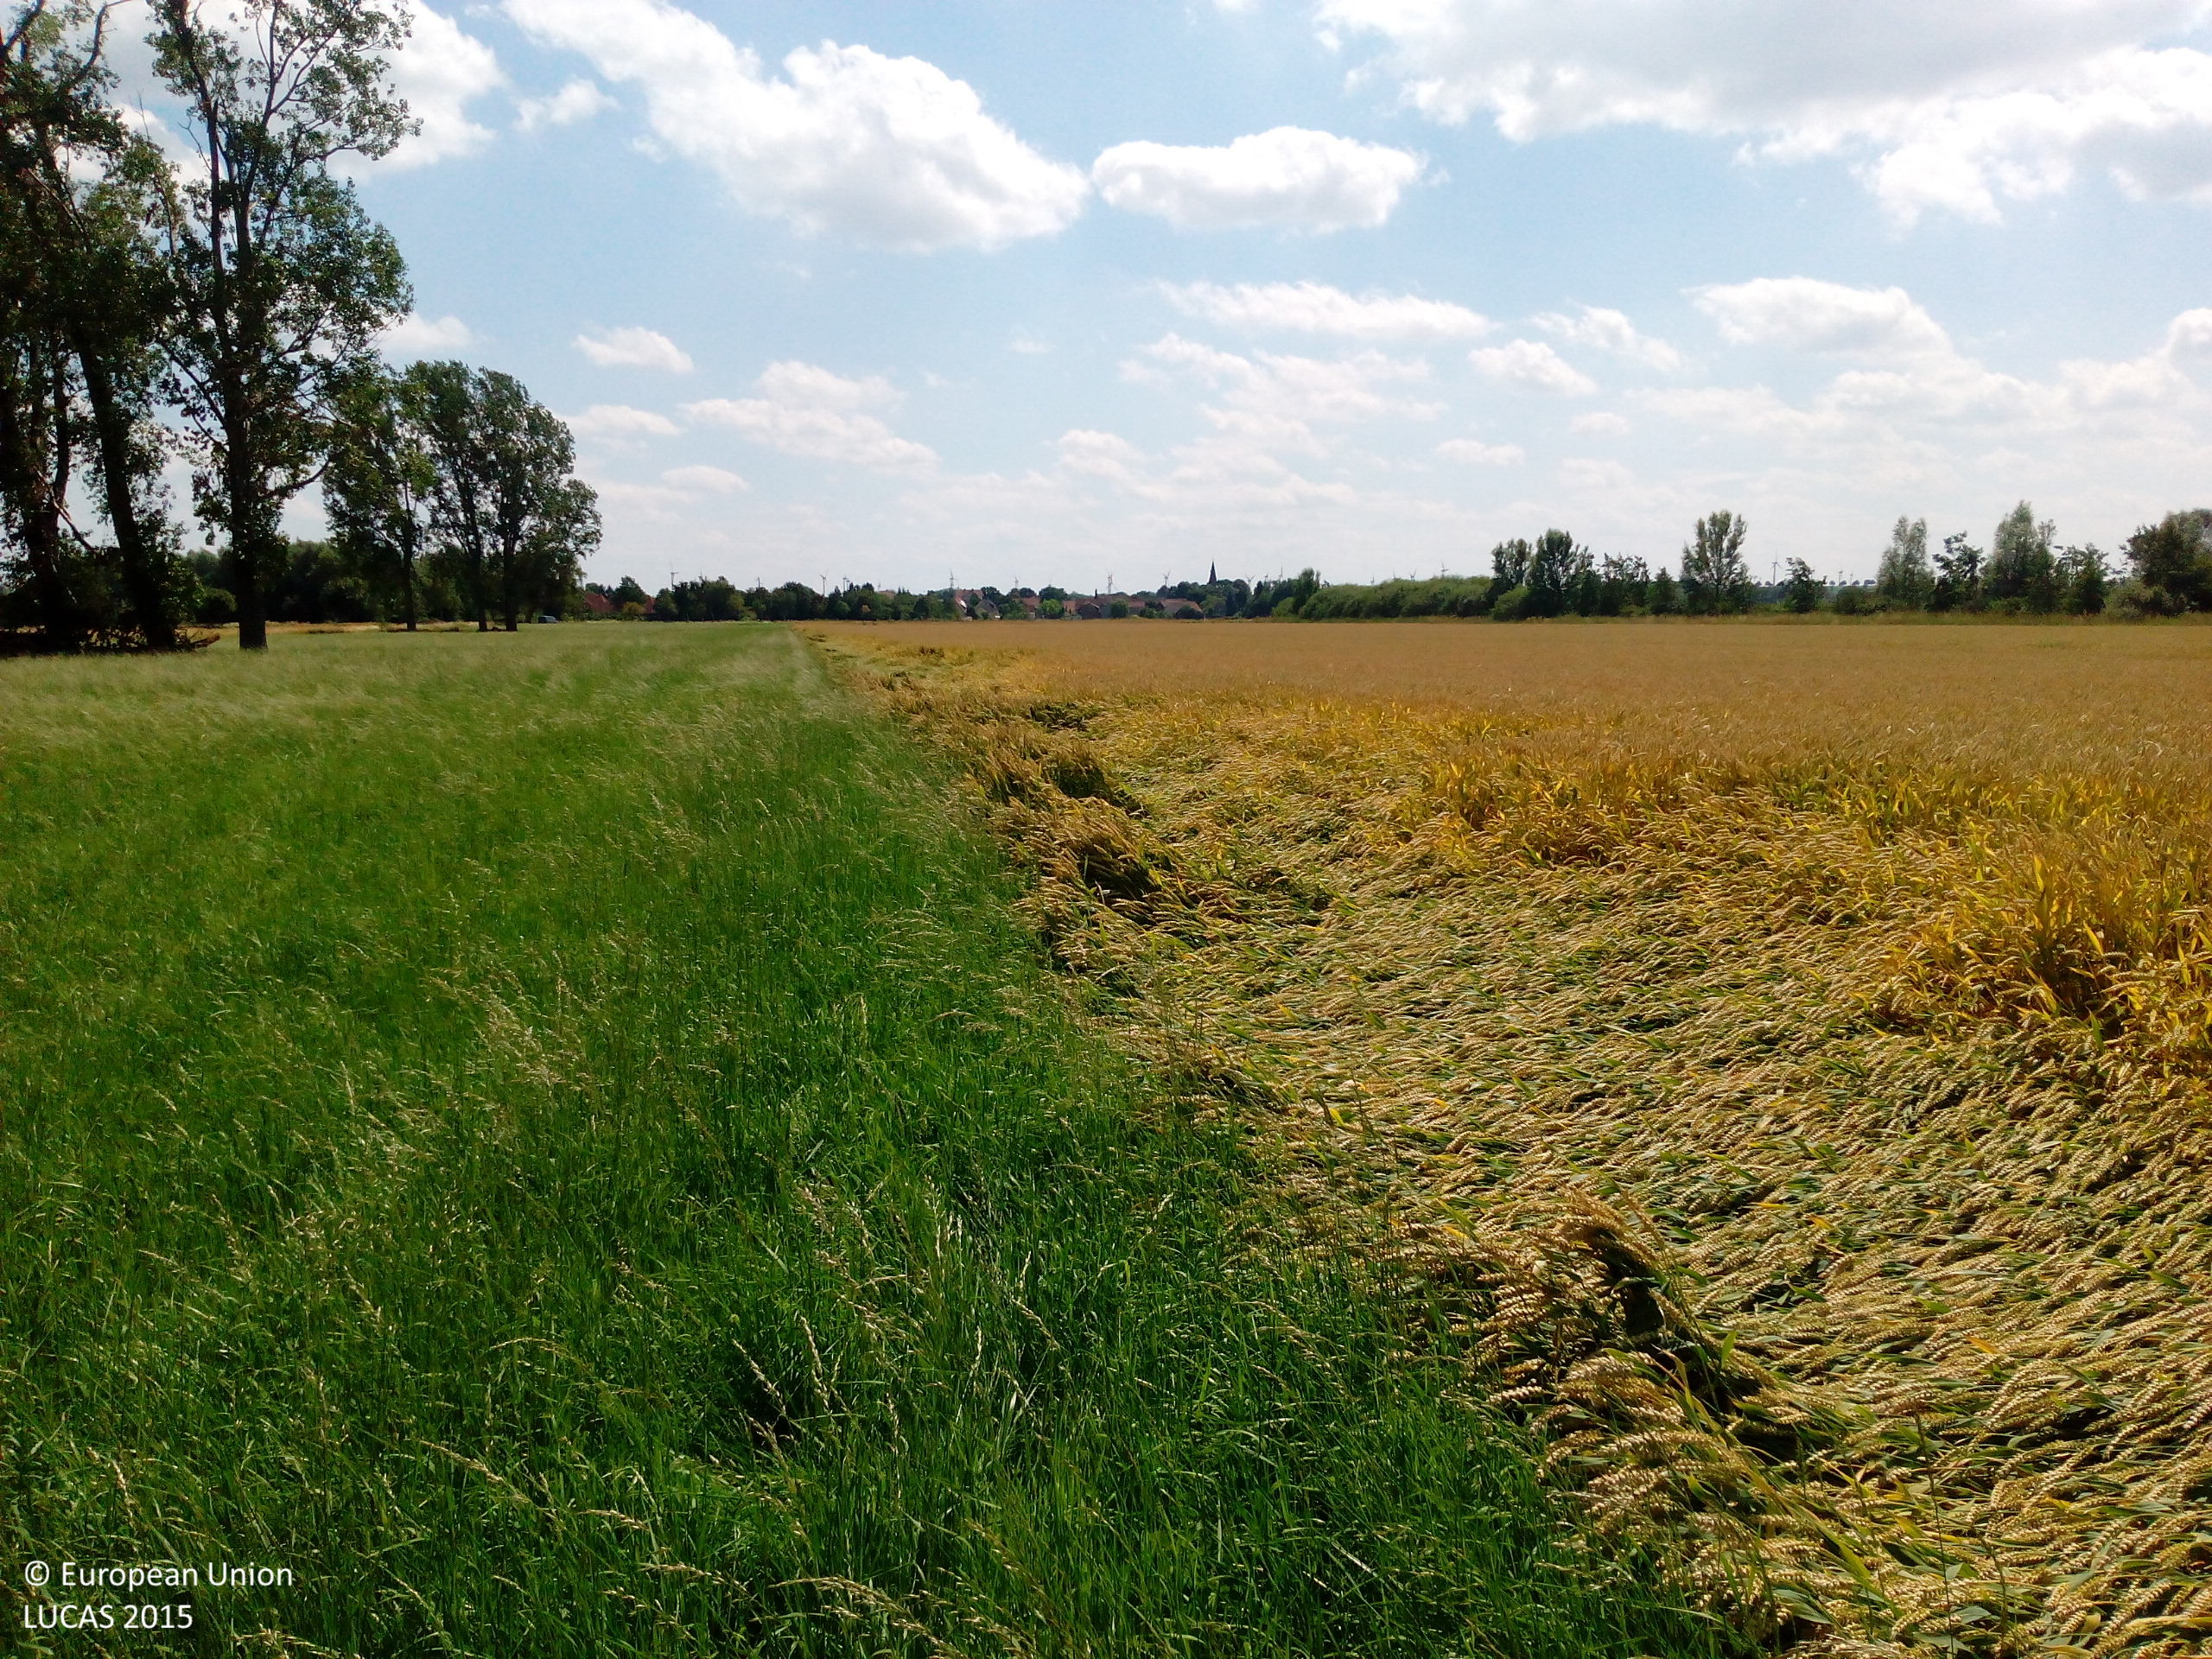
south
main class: Grassland
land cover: Grassland without tree/shrub cover
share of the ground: > 75 %
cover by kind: herbaceous plants 100 %
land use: Agriculture (excluding fallow land and kitchen gardens)
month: July
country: DE
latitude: 52.2154
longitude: 10.2780
